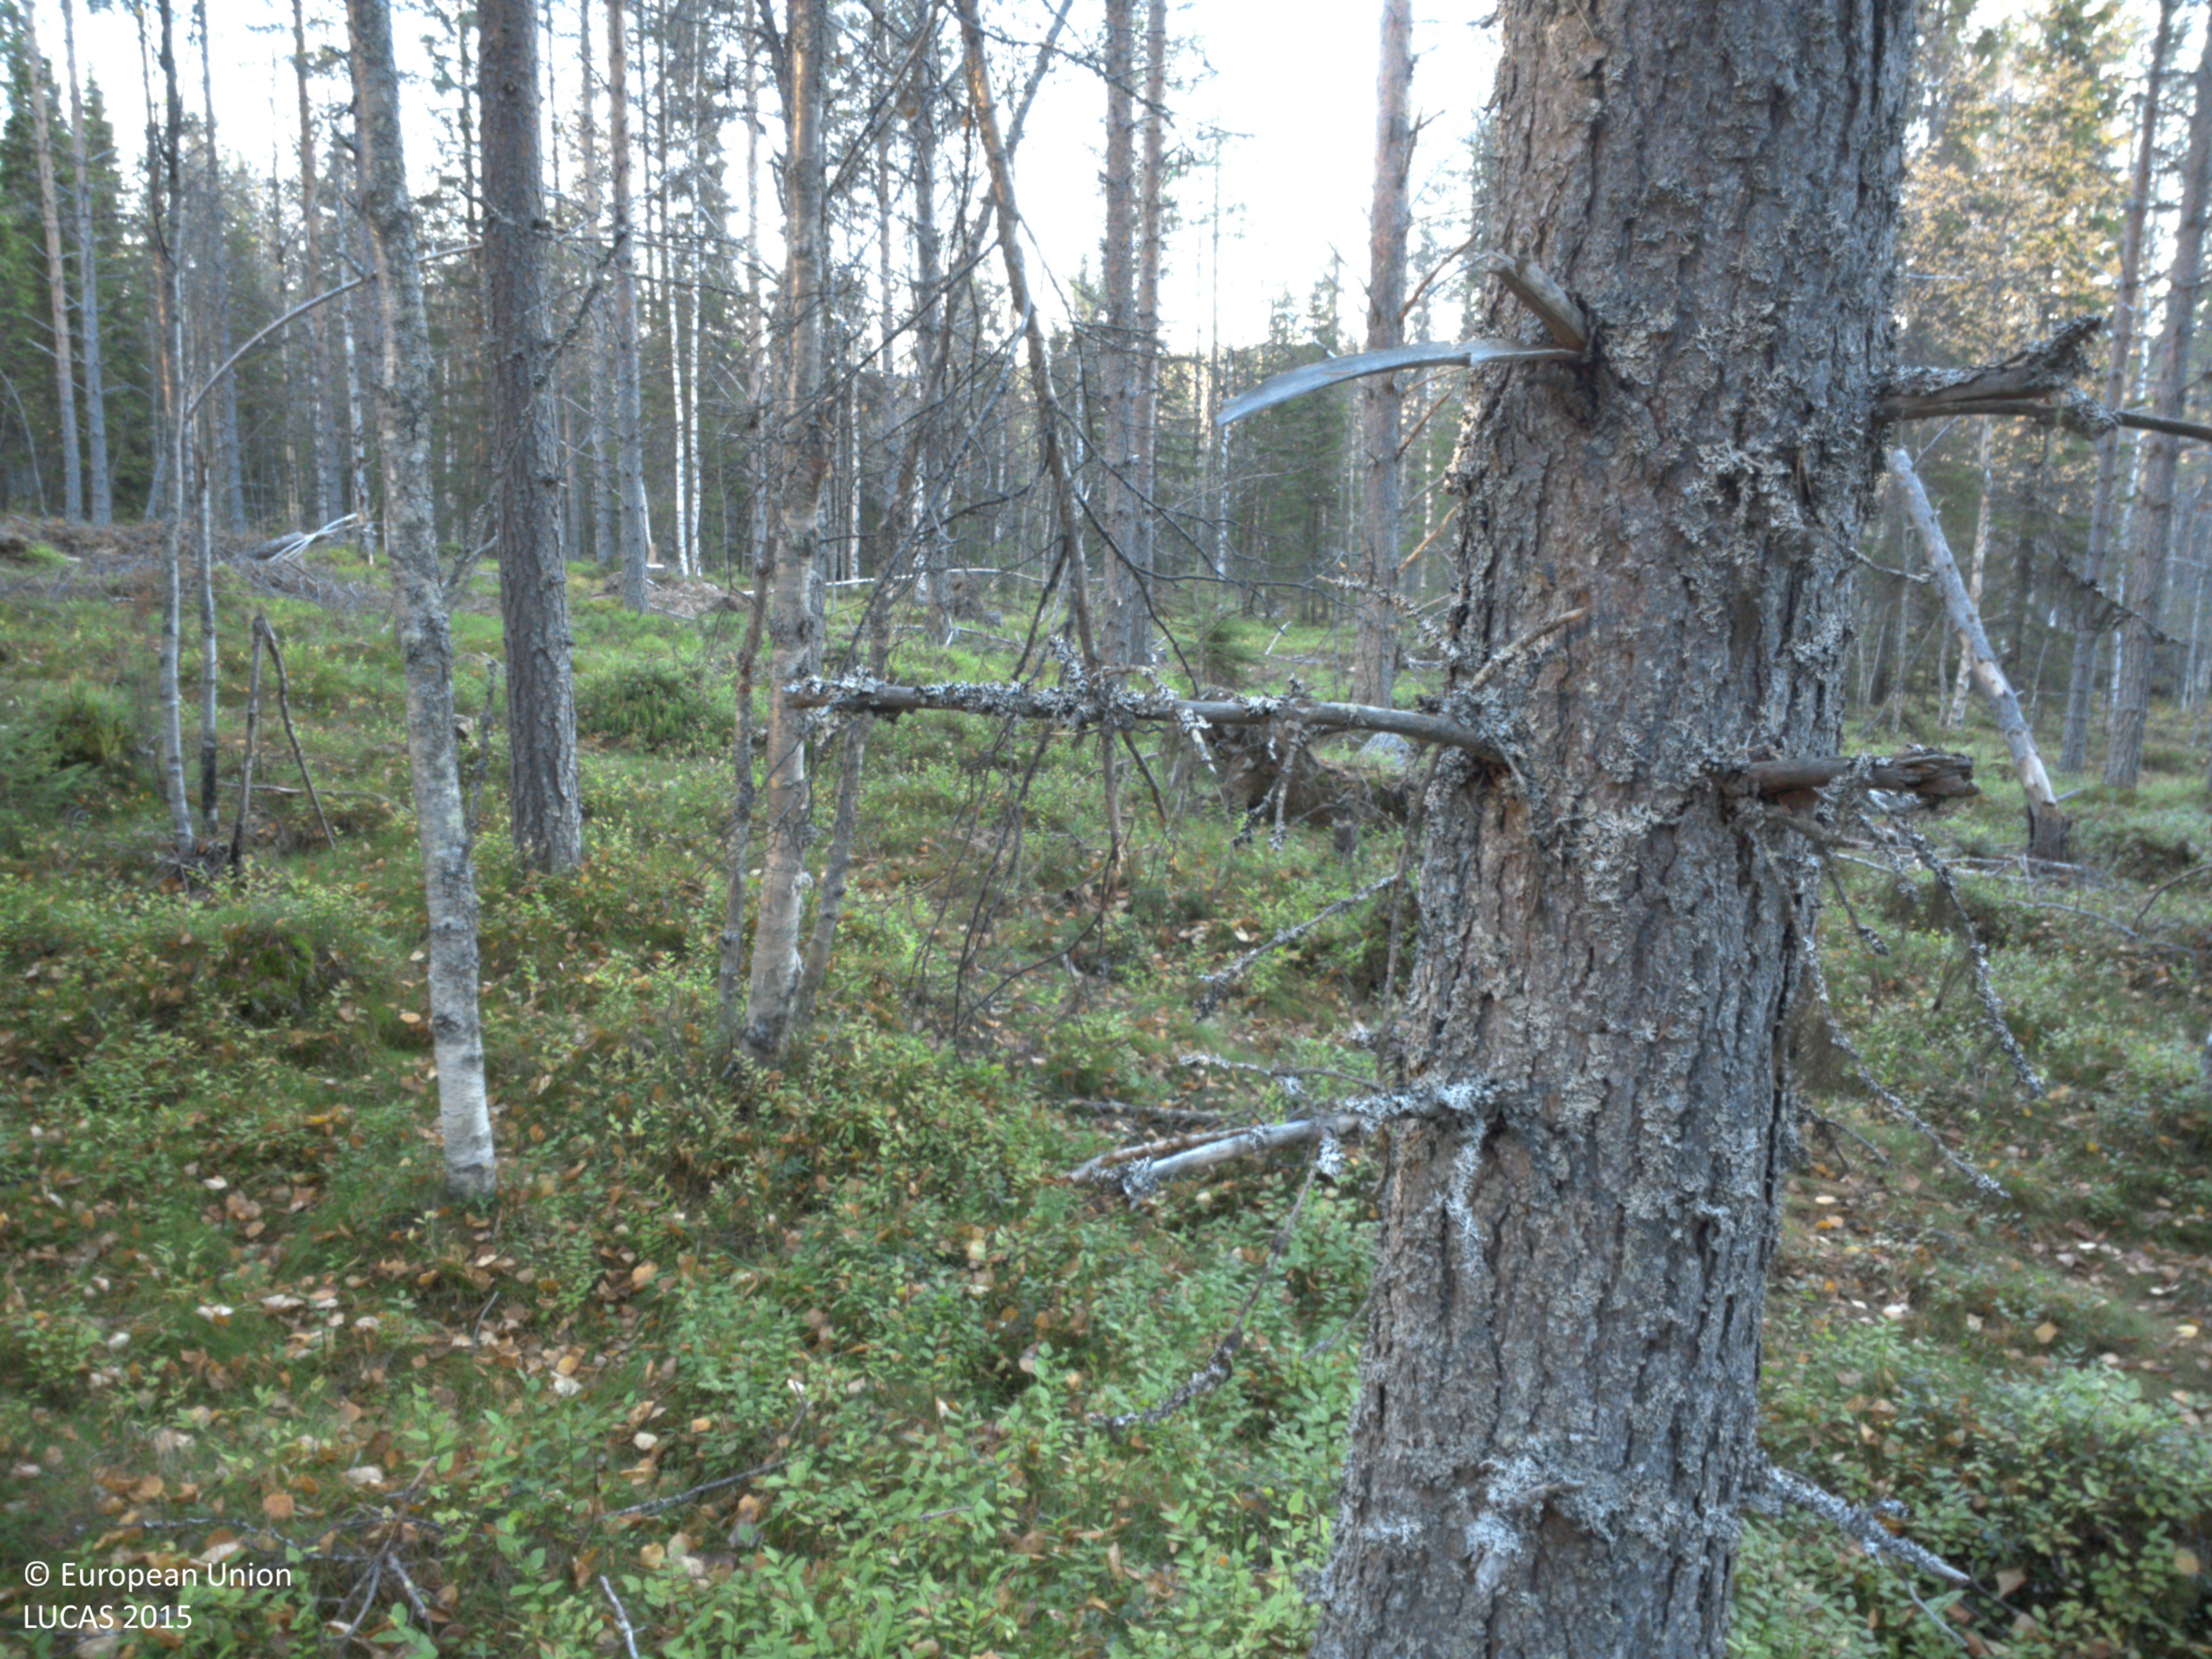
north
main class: Woodland
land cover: Pine dominated coniferous woodland
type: boreal forest
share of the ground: 50 - 75 %
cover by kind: coniferous forest trees 60 %, shrubs 20 %, lichens and mosses 15 %, broadleaved forest trees 5 %
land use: Forestry
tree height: > 5 m
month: October
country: SE
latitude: 64.7171
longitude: 17.7512
